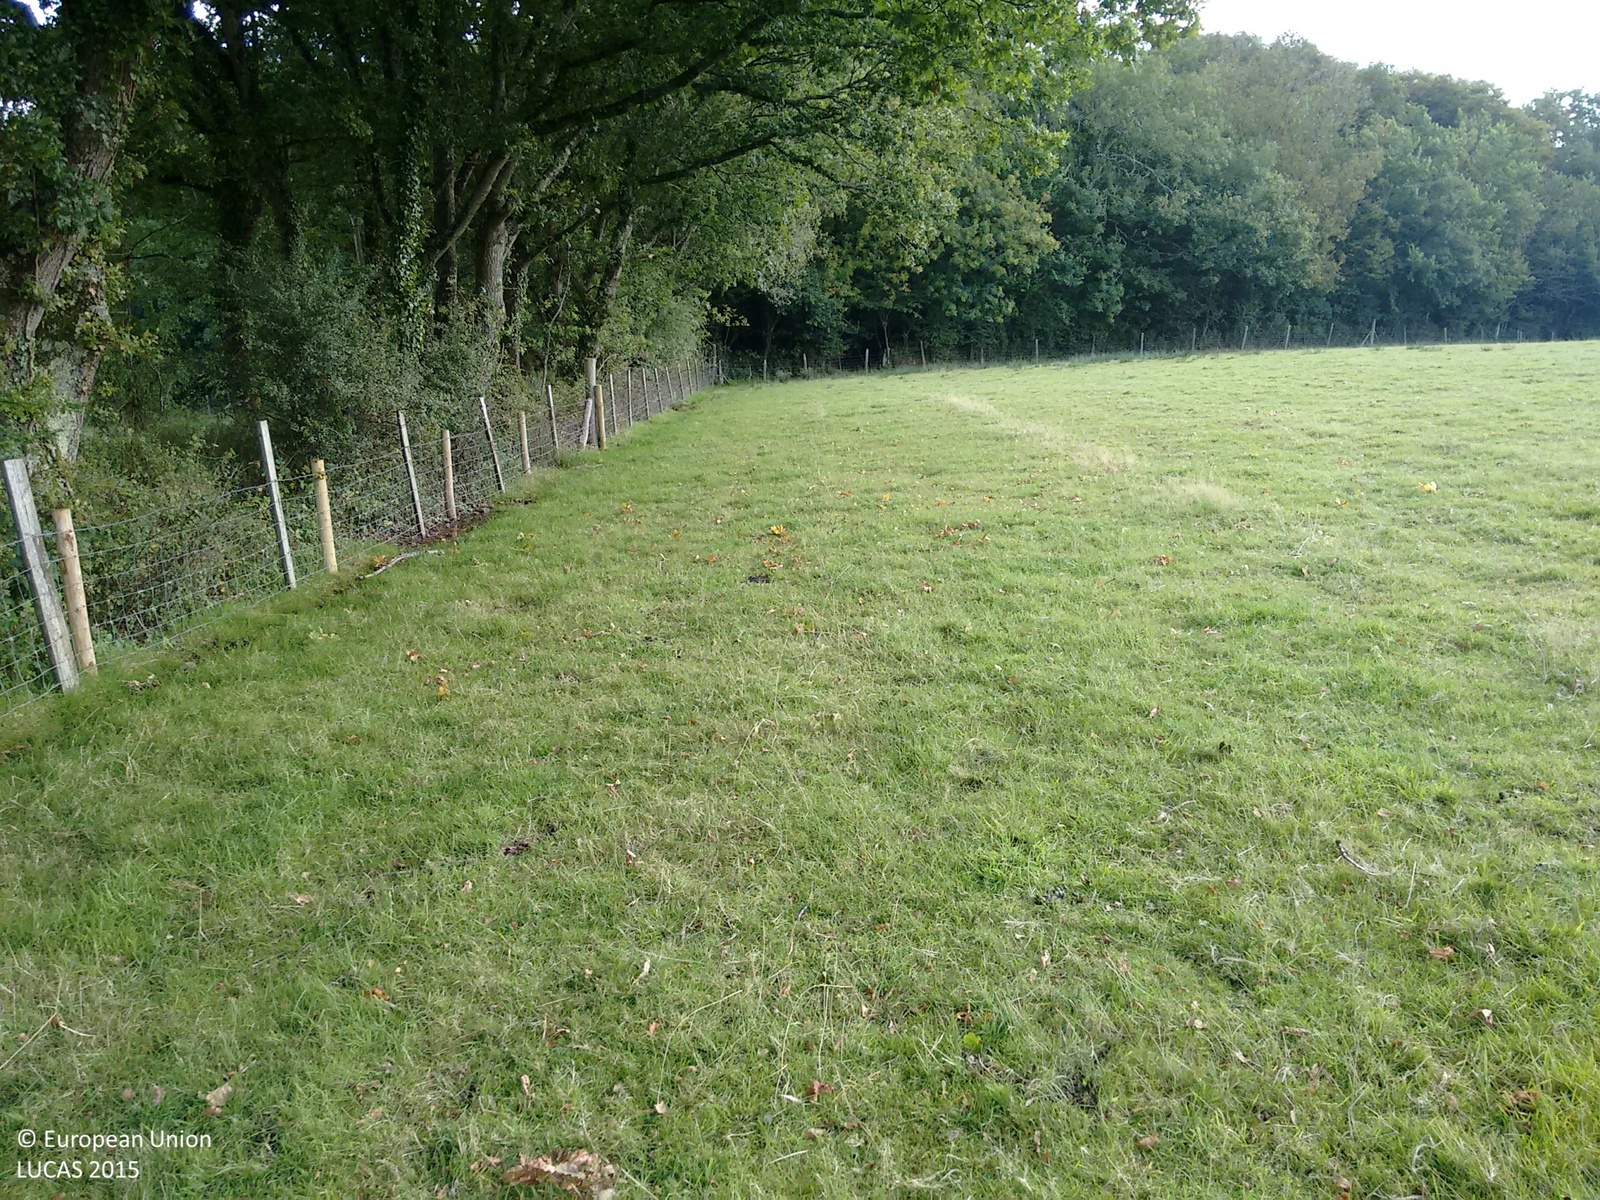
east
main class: Grassland
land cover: Grassland without tree/shrub cover
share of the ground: > 75 %
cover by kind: herbaceous plants 100 %
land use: Agriculture (excluding fallow land and kitchen gardens)
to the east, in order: Grassland without tree/shrub cover; Fences; Broadleaved woodland
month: September
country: GB
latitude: 50.8383
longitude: -4.0831
